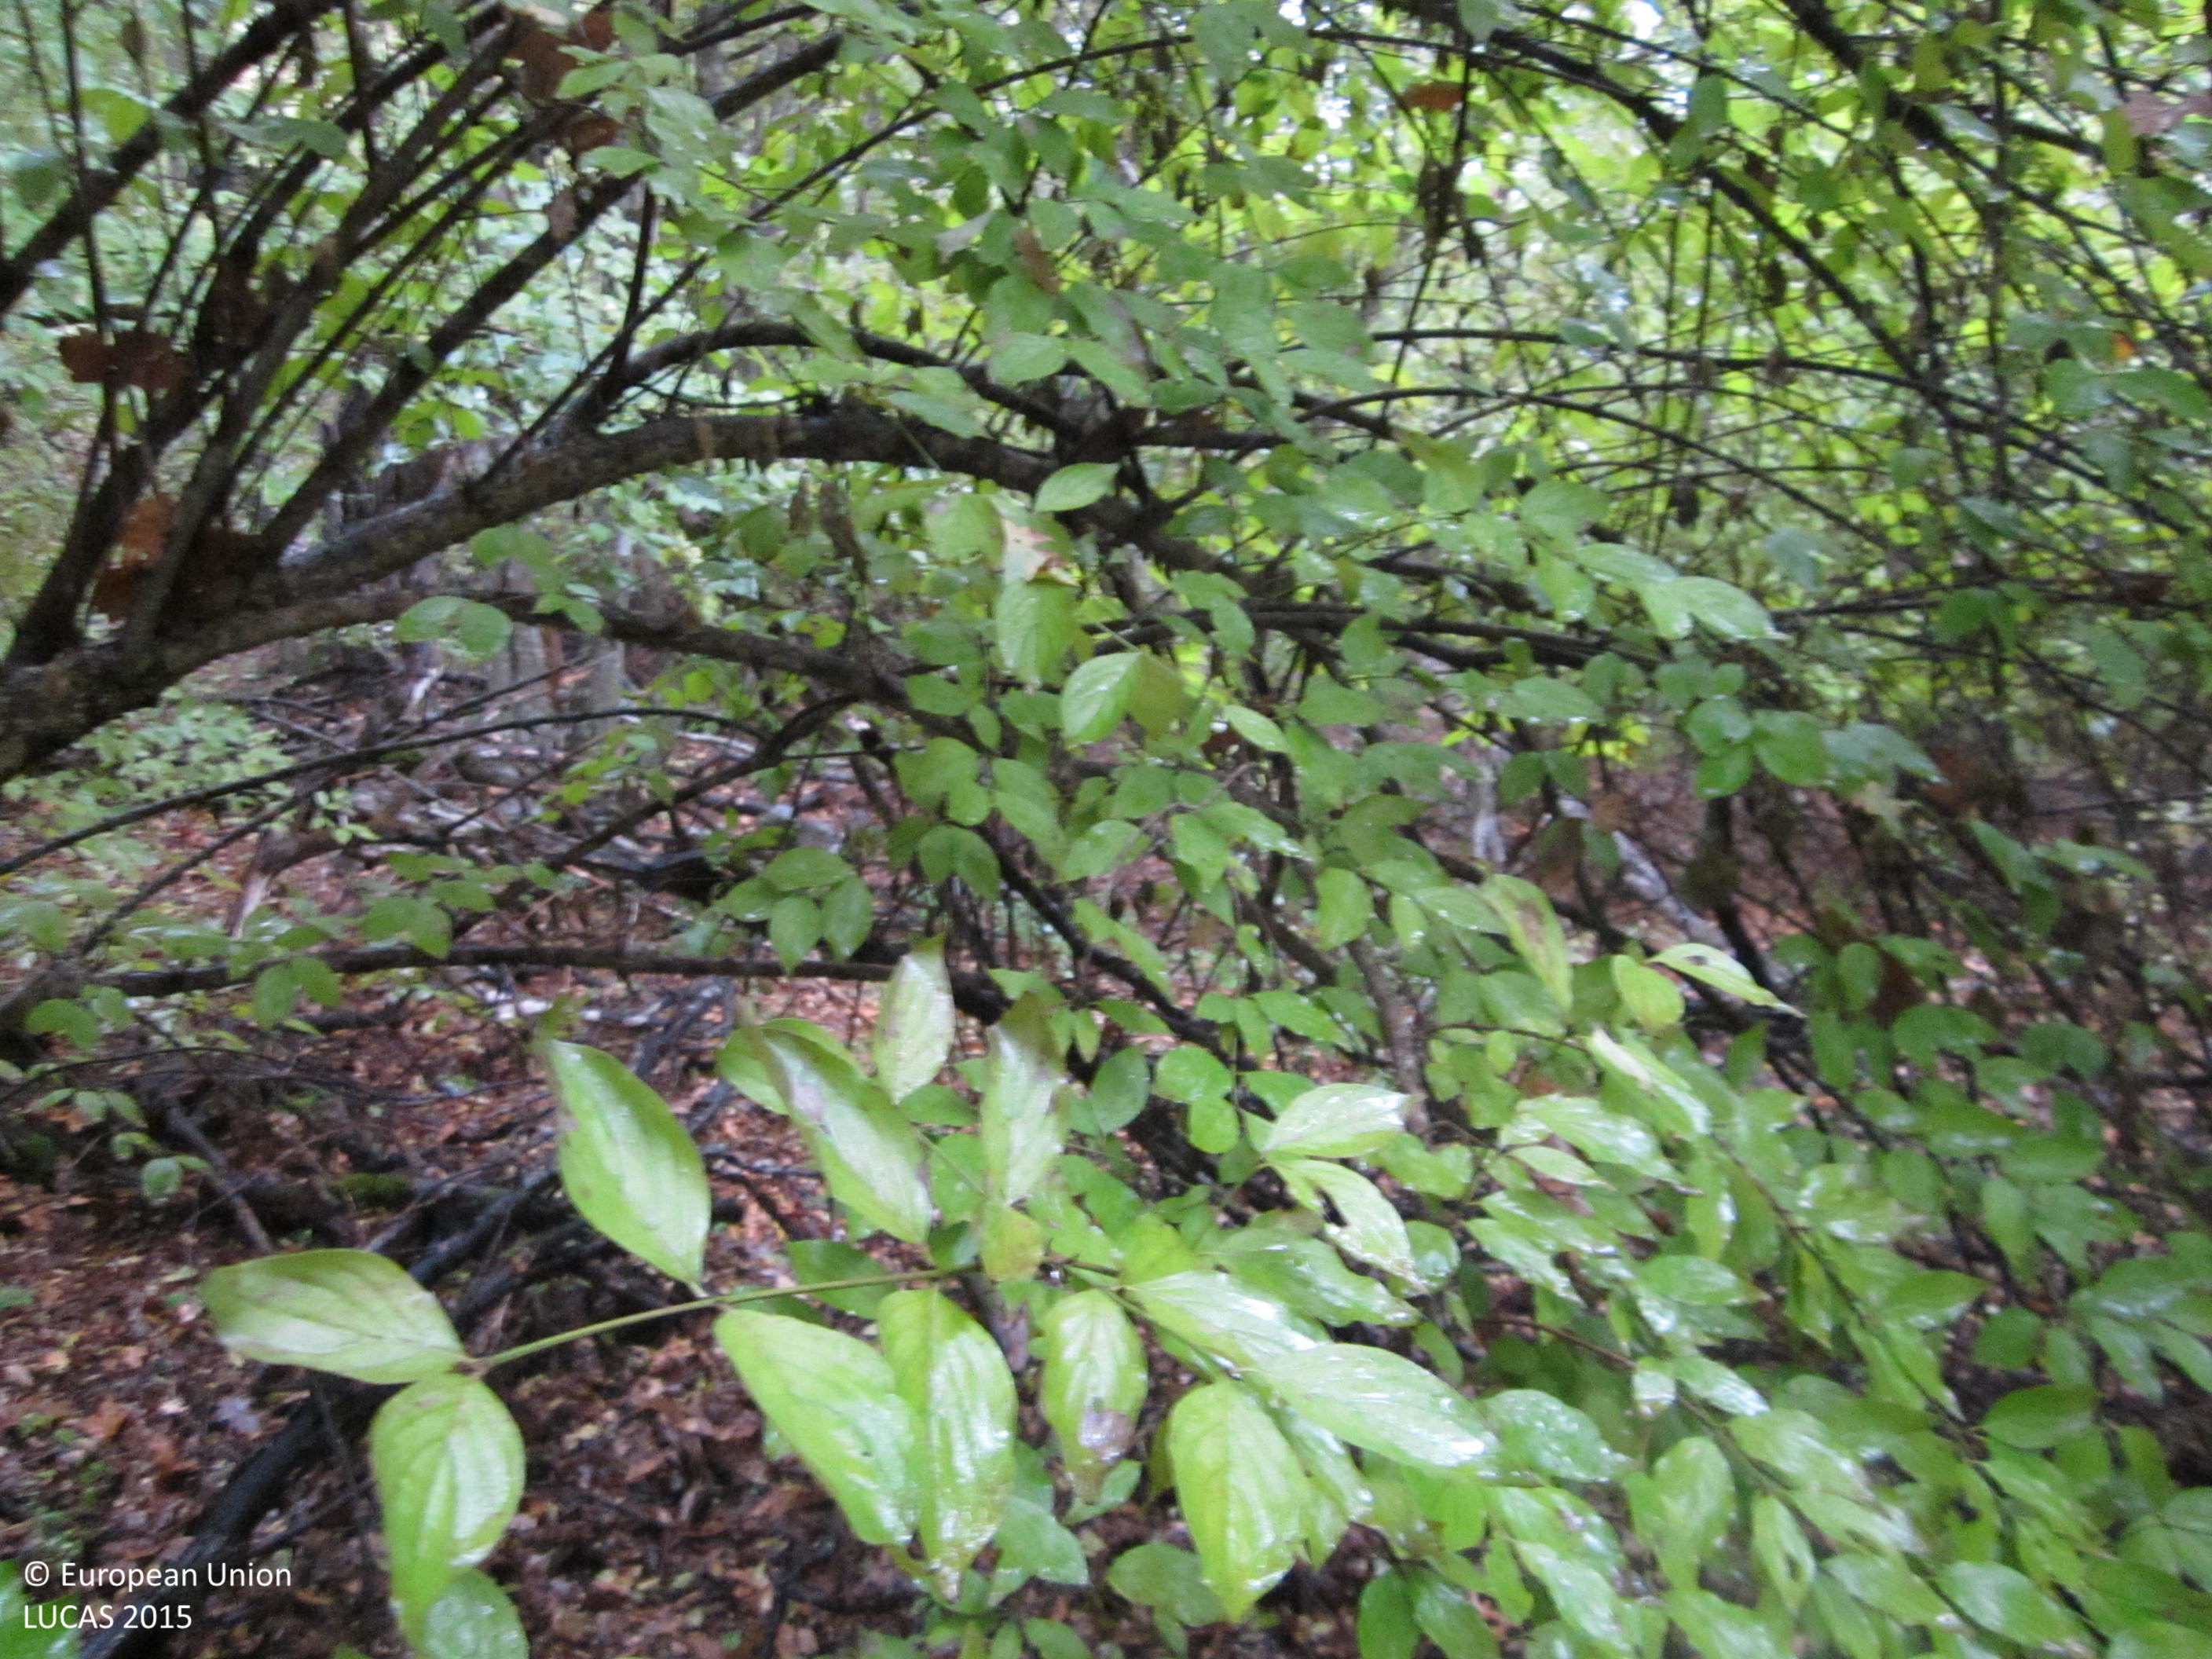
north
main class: Woodland
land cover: Broadleaved woodland
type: mesophytic deciduous forest
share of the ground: > 75 %
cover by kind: broadleaved forest trees 100 %
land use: Forestry
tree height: > 5 m
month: October
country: BG
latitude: 42.1414
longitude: 27.2265
